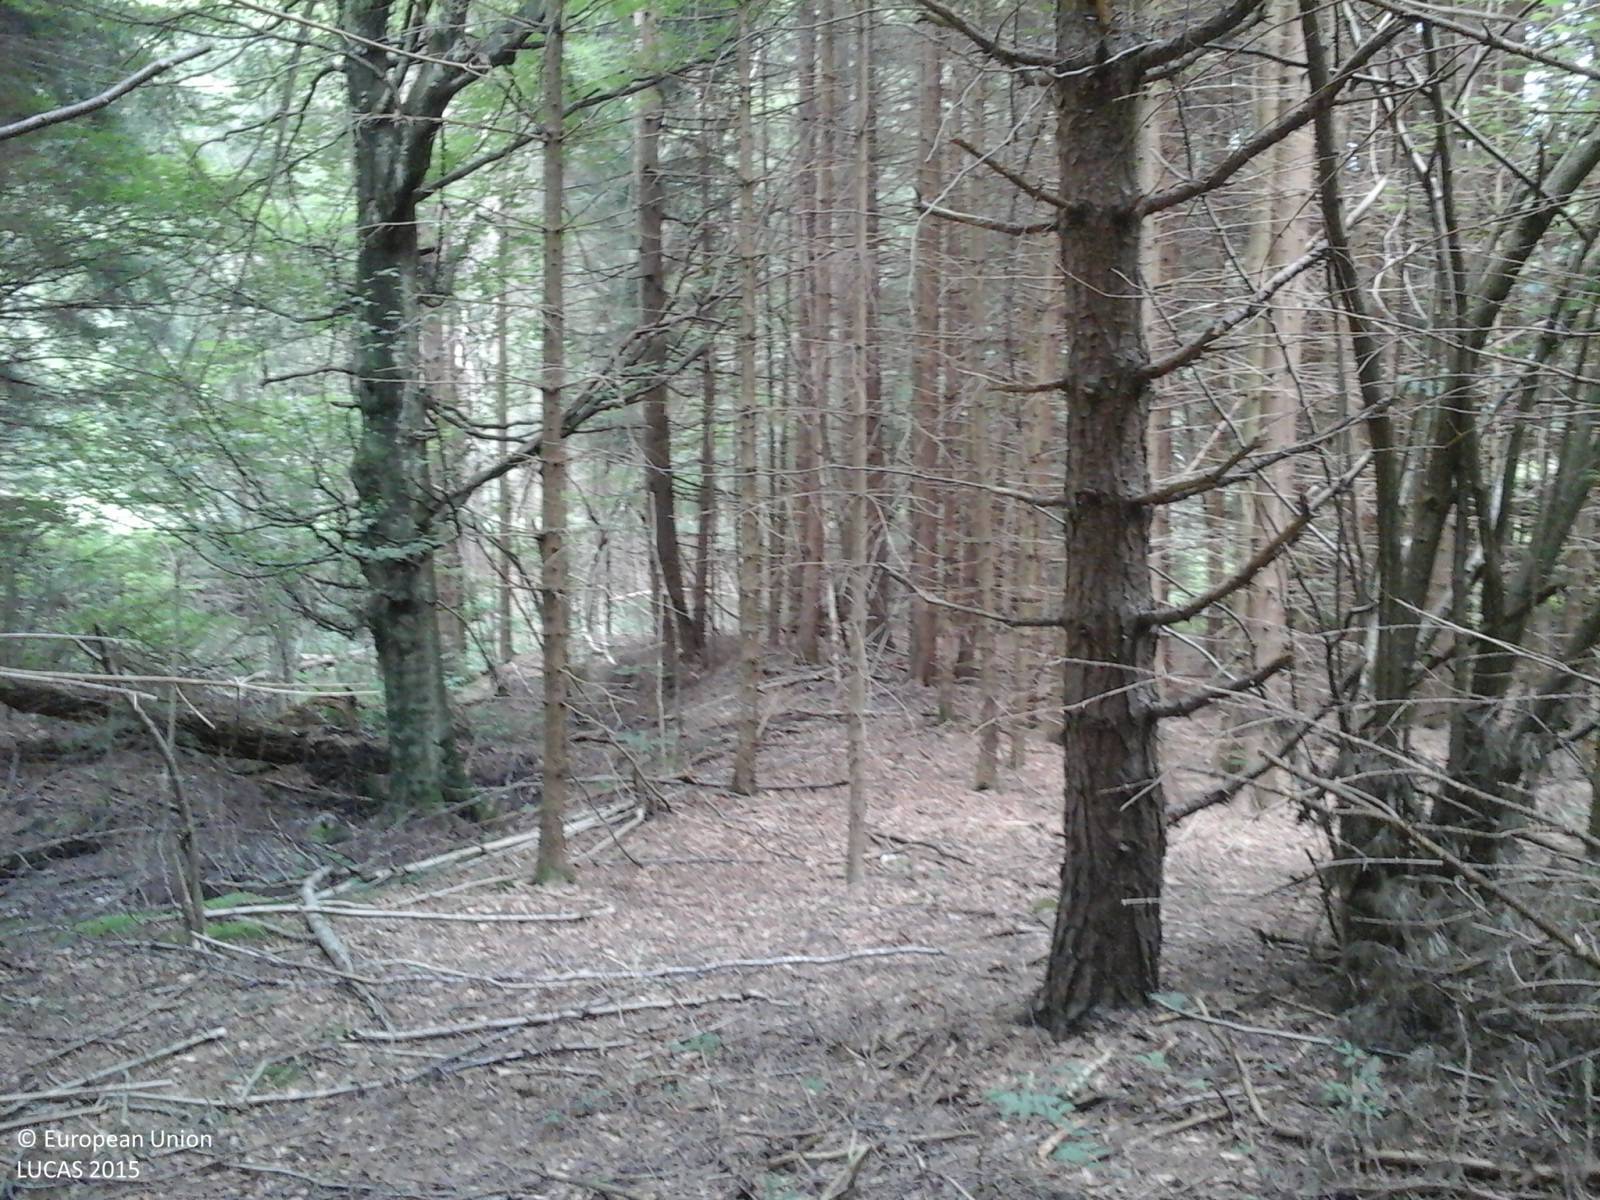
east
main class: Woodland
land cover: Other mixed woodland
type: alpine coniferous forest
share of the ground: > 75 %
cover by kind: coniferous forest trees 70 %, broadleaved forest trees 30 %
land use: Forestry
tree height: > 5 m
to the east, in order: Other mixed woodland; Rivers and streams; Other mixed woodland; Grassland without tree/shrub cover; Broadleaved woodland; Rivers and streams; Broadleaved woodland; Electric lines; Grassland without tree/shrub cover; Other mixed woodland
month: July
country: IT
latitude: 46.4180
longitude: 12.9764
